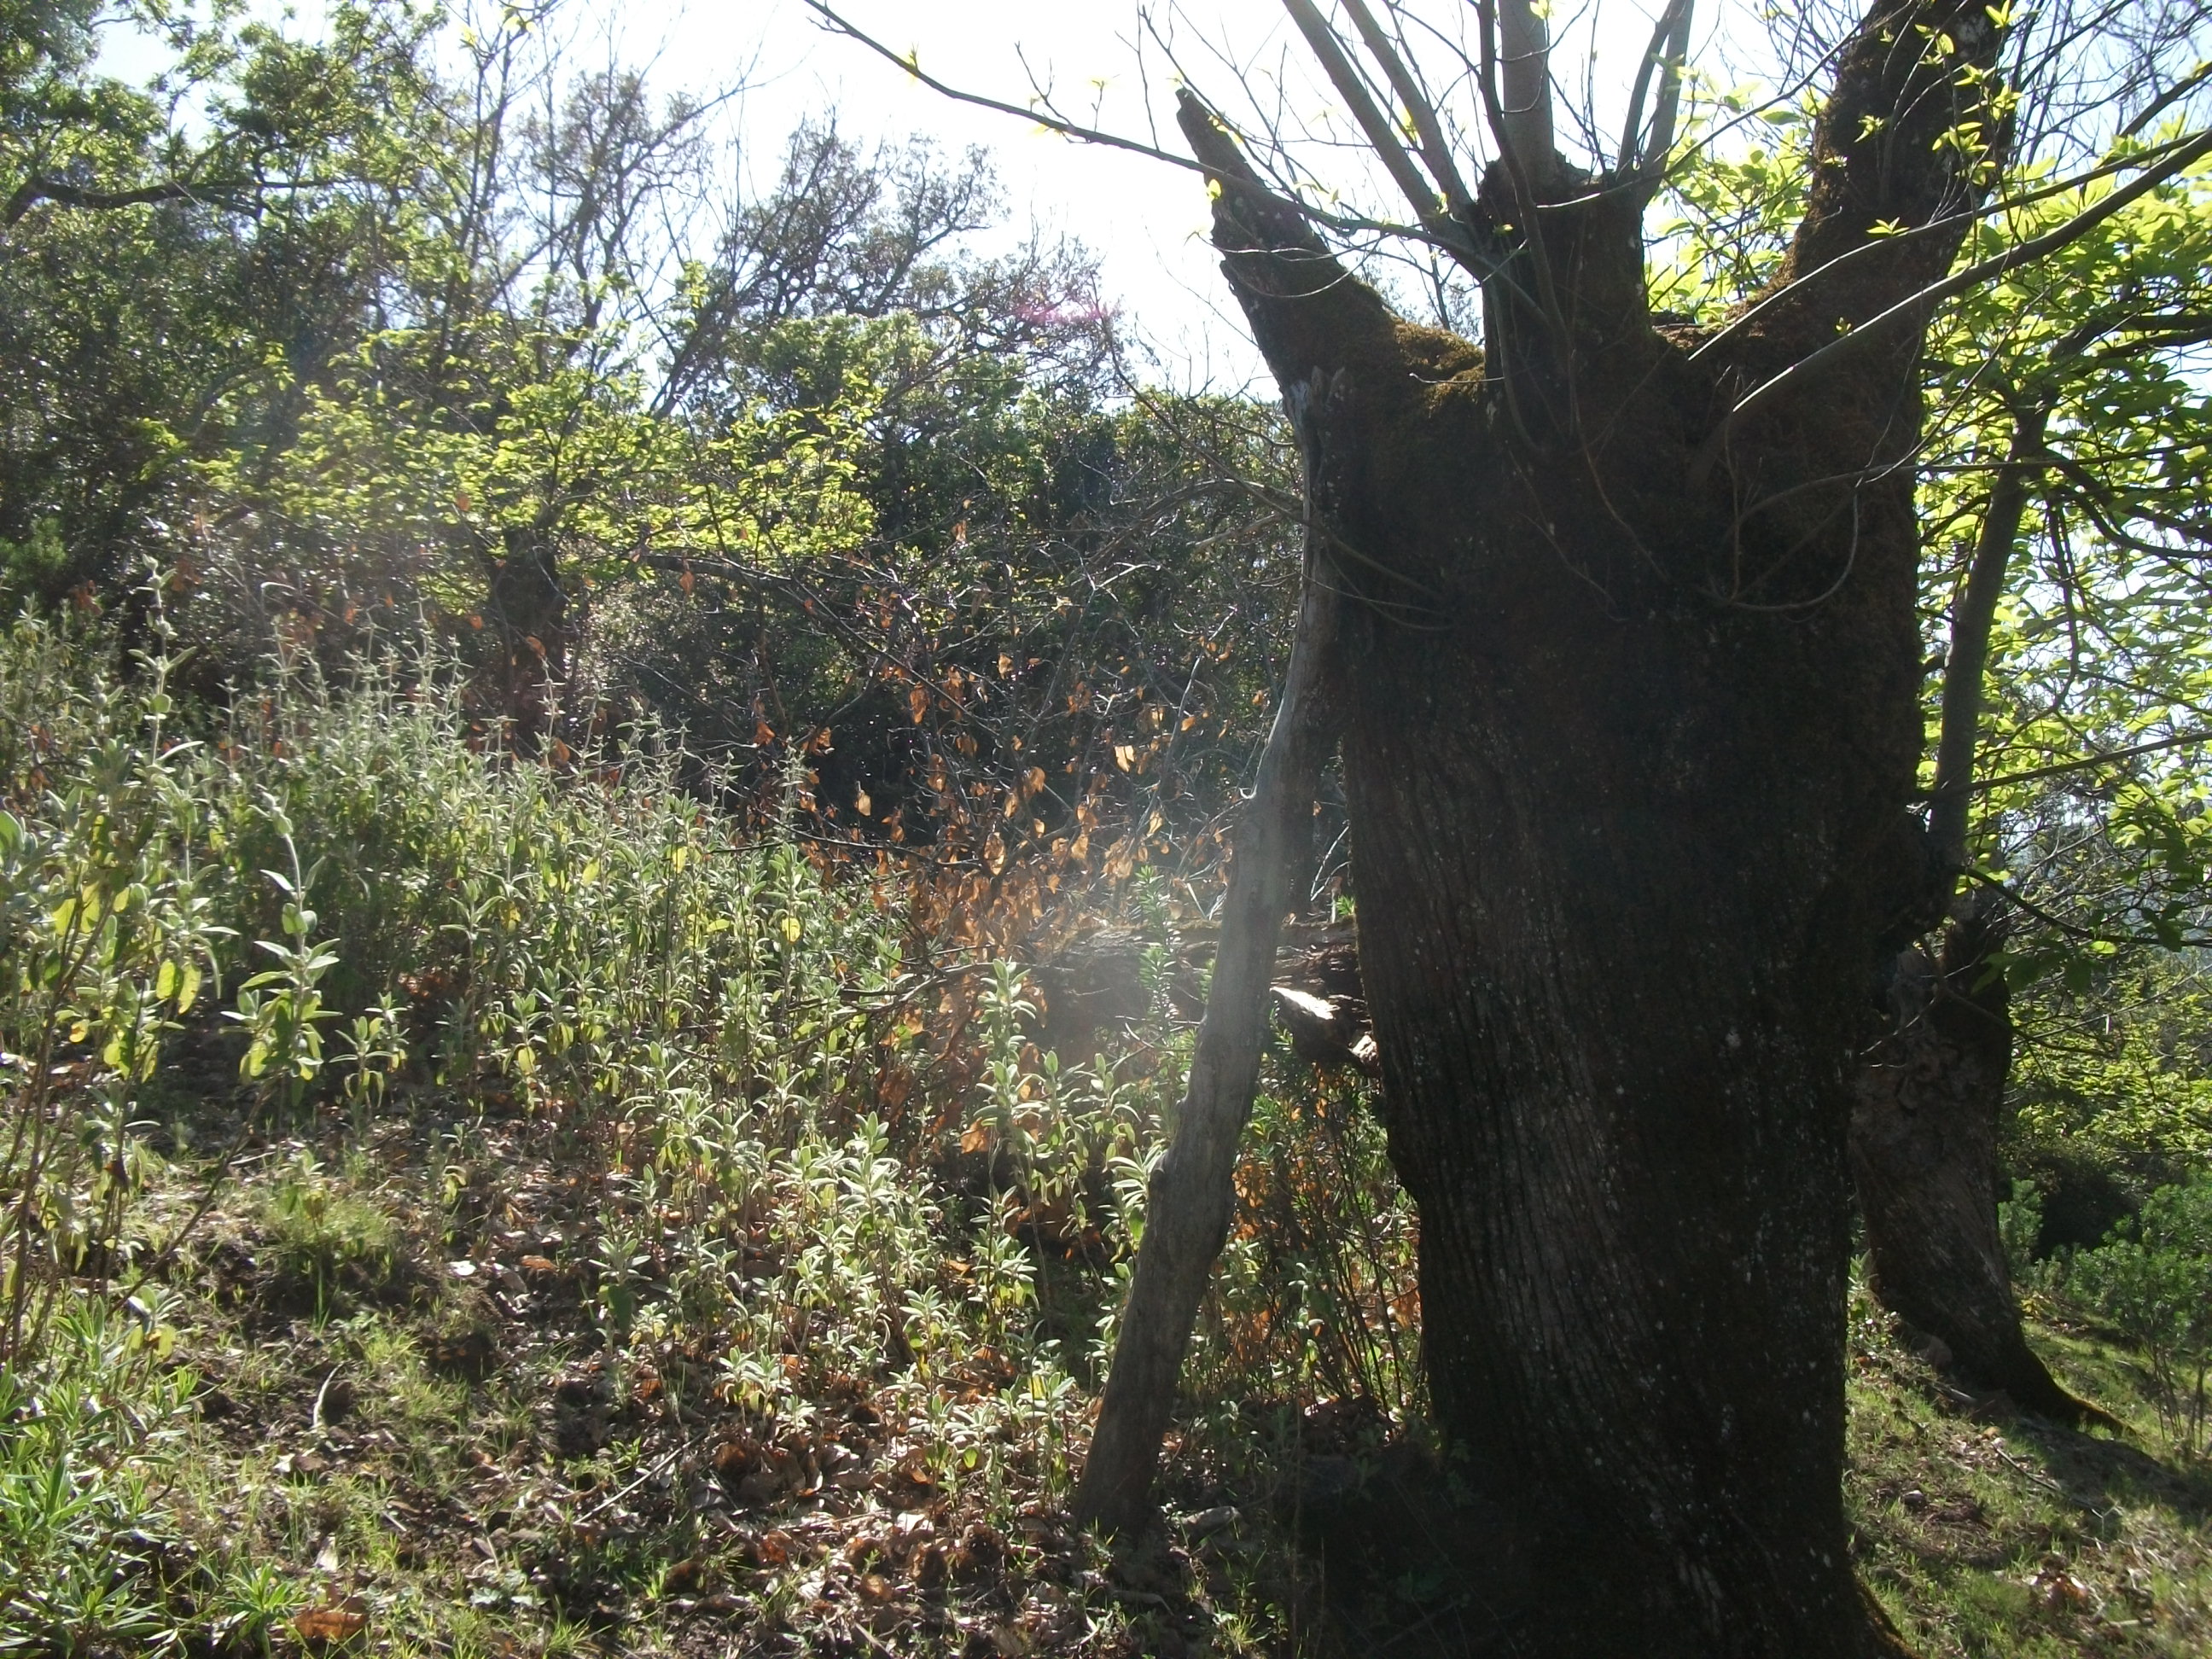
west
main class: Cropland
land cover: Nuts trees
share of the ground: 50 - 75 %
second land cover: Spontaneously vegetated surfaces
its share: > 75 %
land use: Agriculture (excluding fallow land and kitchen gardens)
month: April
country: ES
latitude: 37.8815
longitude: -6.6096
